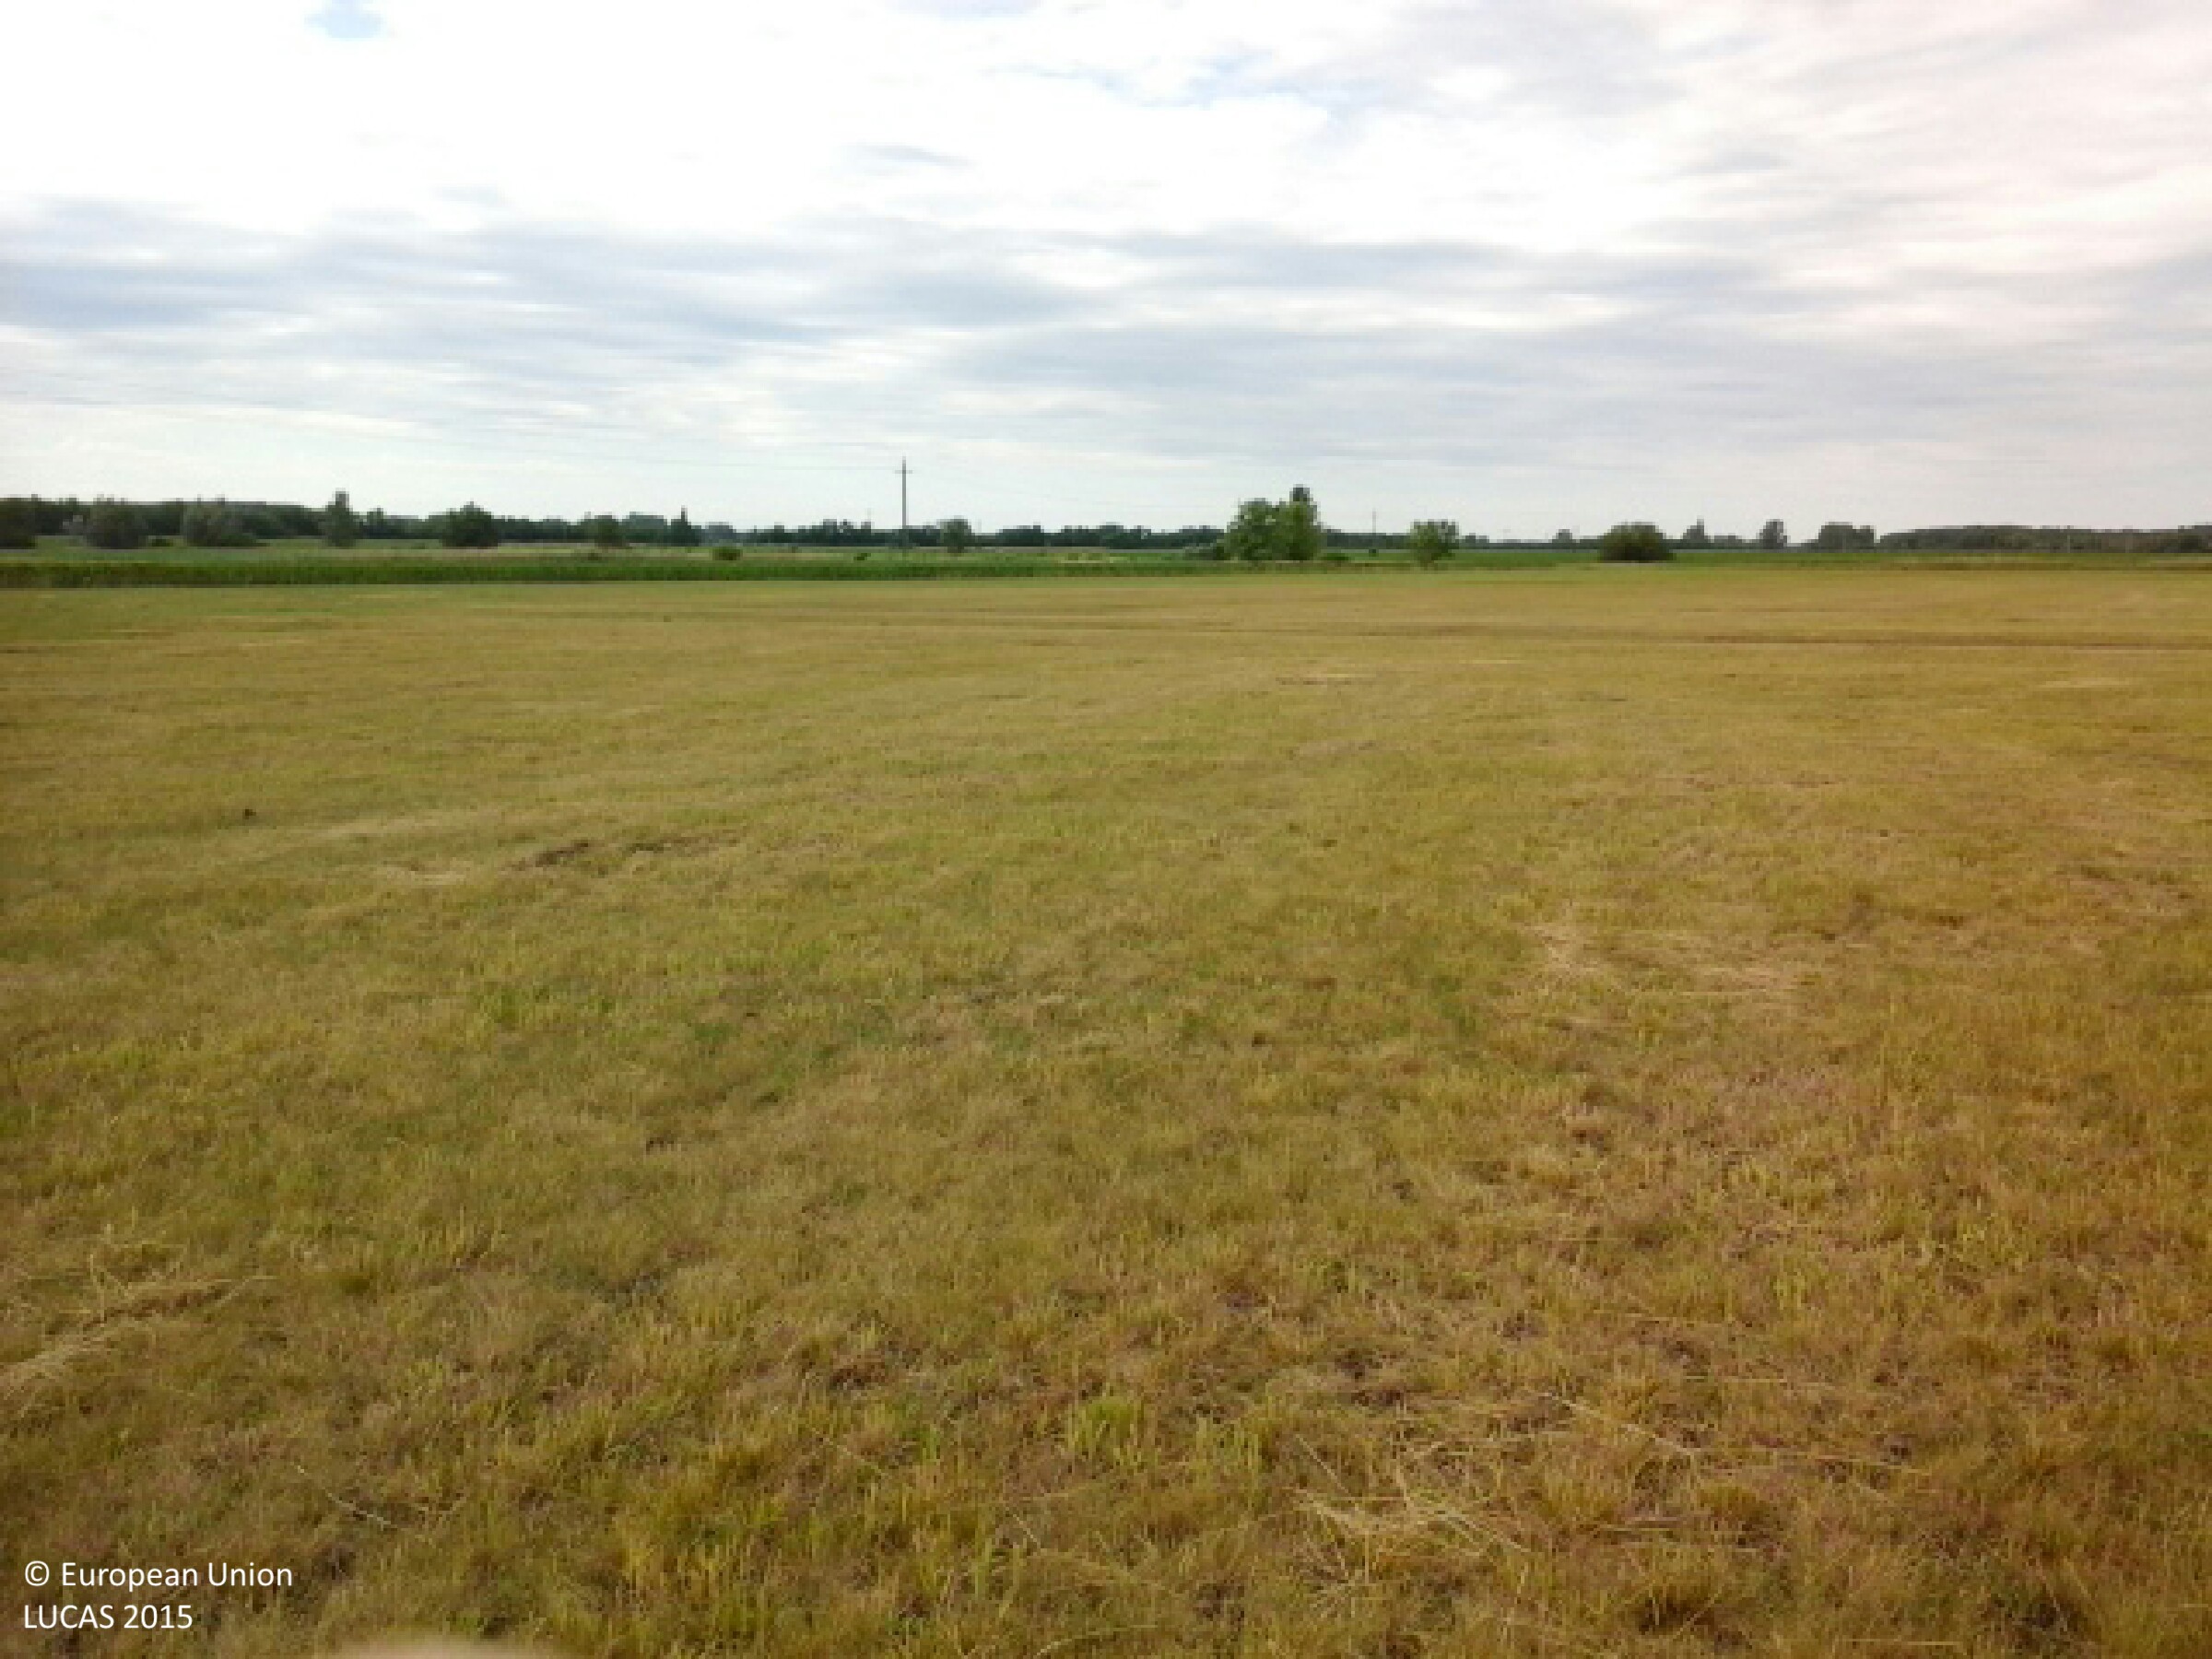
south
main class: Grassland
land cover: Grassland without tree/shrub cover
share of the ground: > 75 %
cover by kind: herbaceous plants 95 %, unconsolidated bare surface 5 %
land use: Agriculture (excluding fallow land and kitchen gardens)
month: June
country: HU
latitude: 48.0462
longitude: 21.7597
